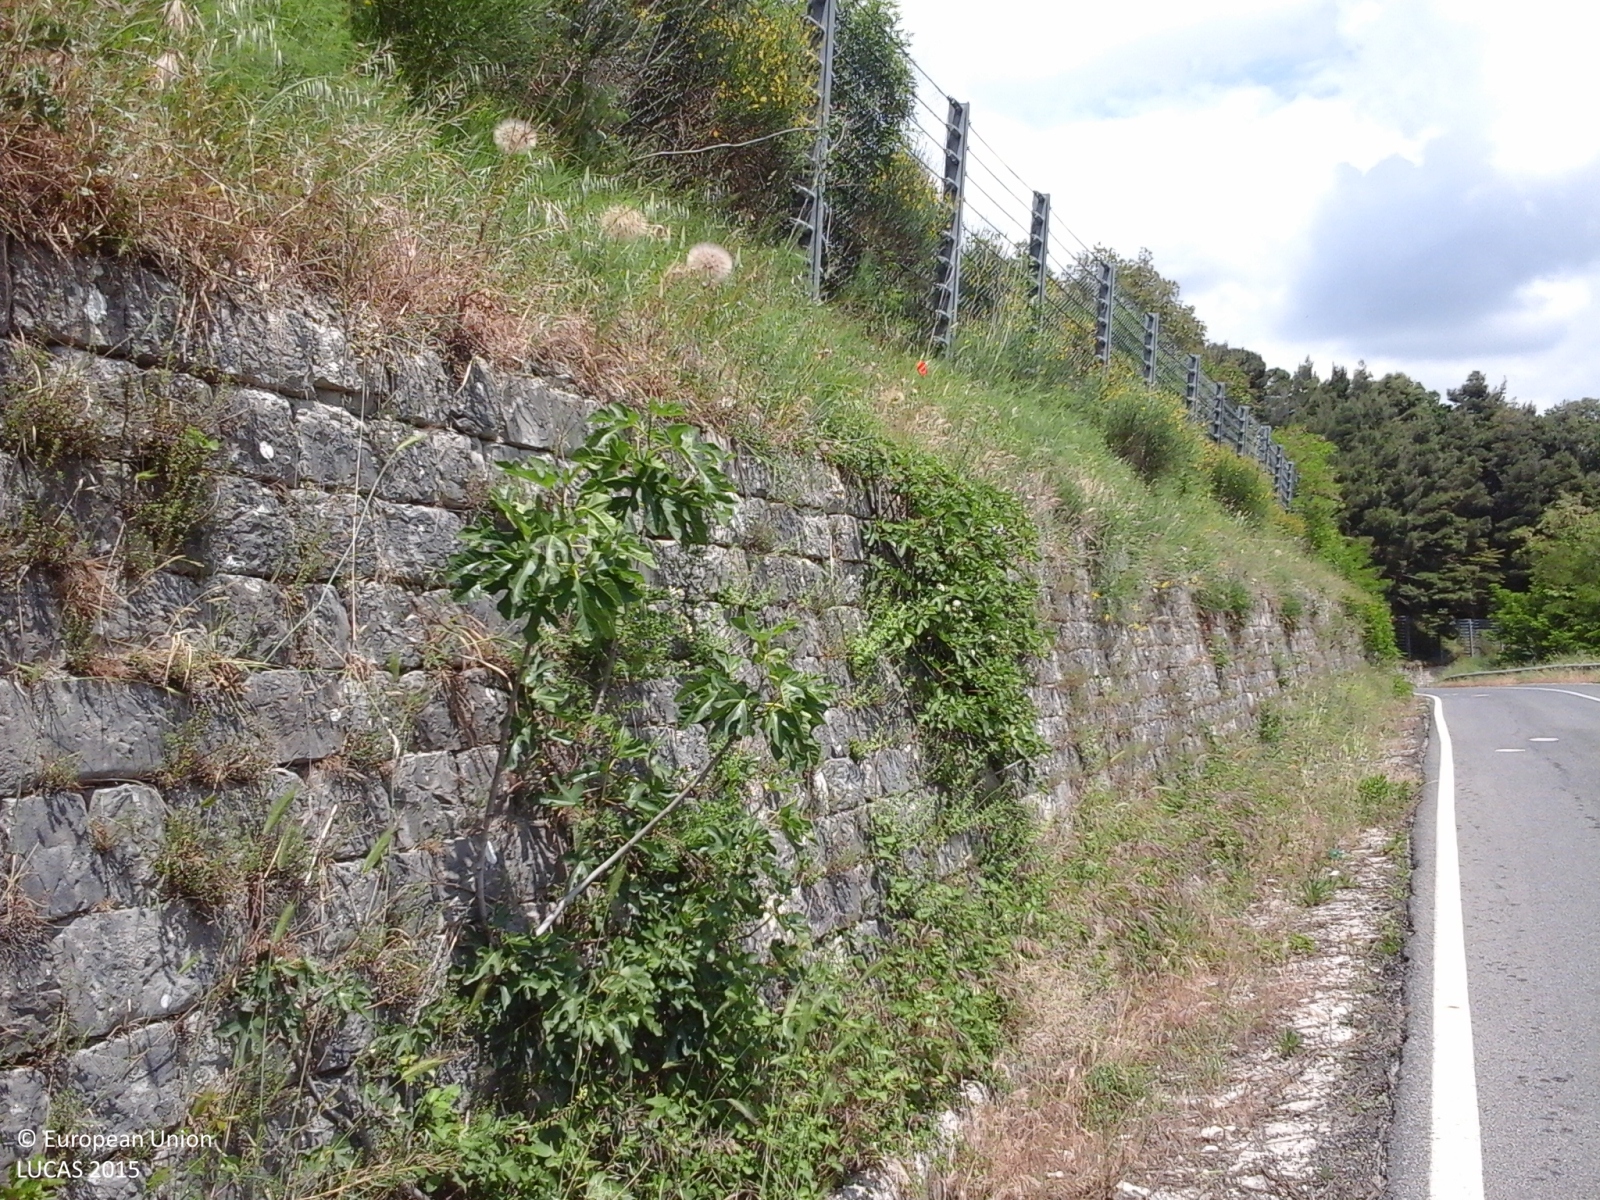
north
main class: Shrubland
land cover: Shrubland with sparse tree cover
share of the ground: > 75 %
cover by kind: shrubs 75 %, herbaceous plants 20 %, coniferous forest trees 5 %
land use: Semi-natural and natural areas not in use
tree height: > 5 m
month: May
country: IT
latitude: 41.2365
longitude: 15.1716
